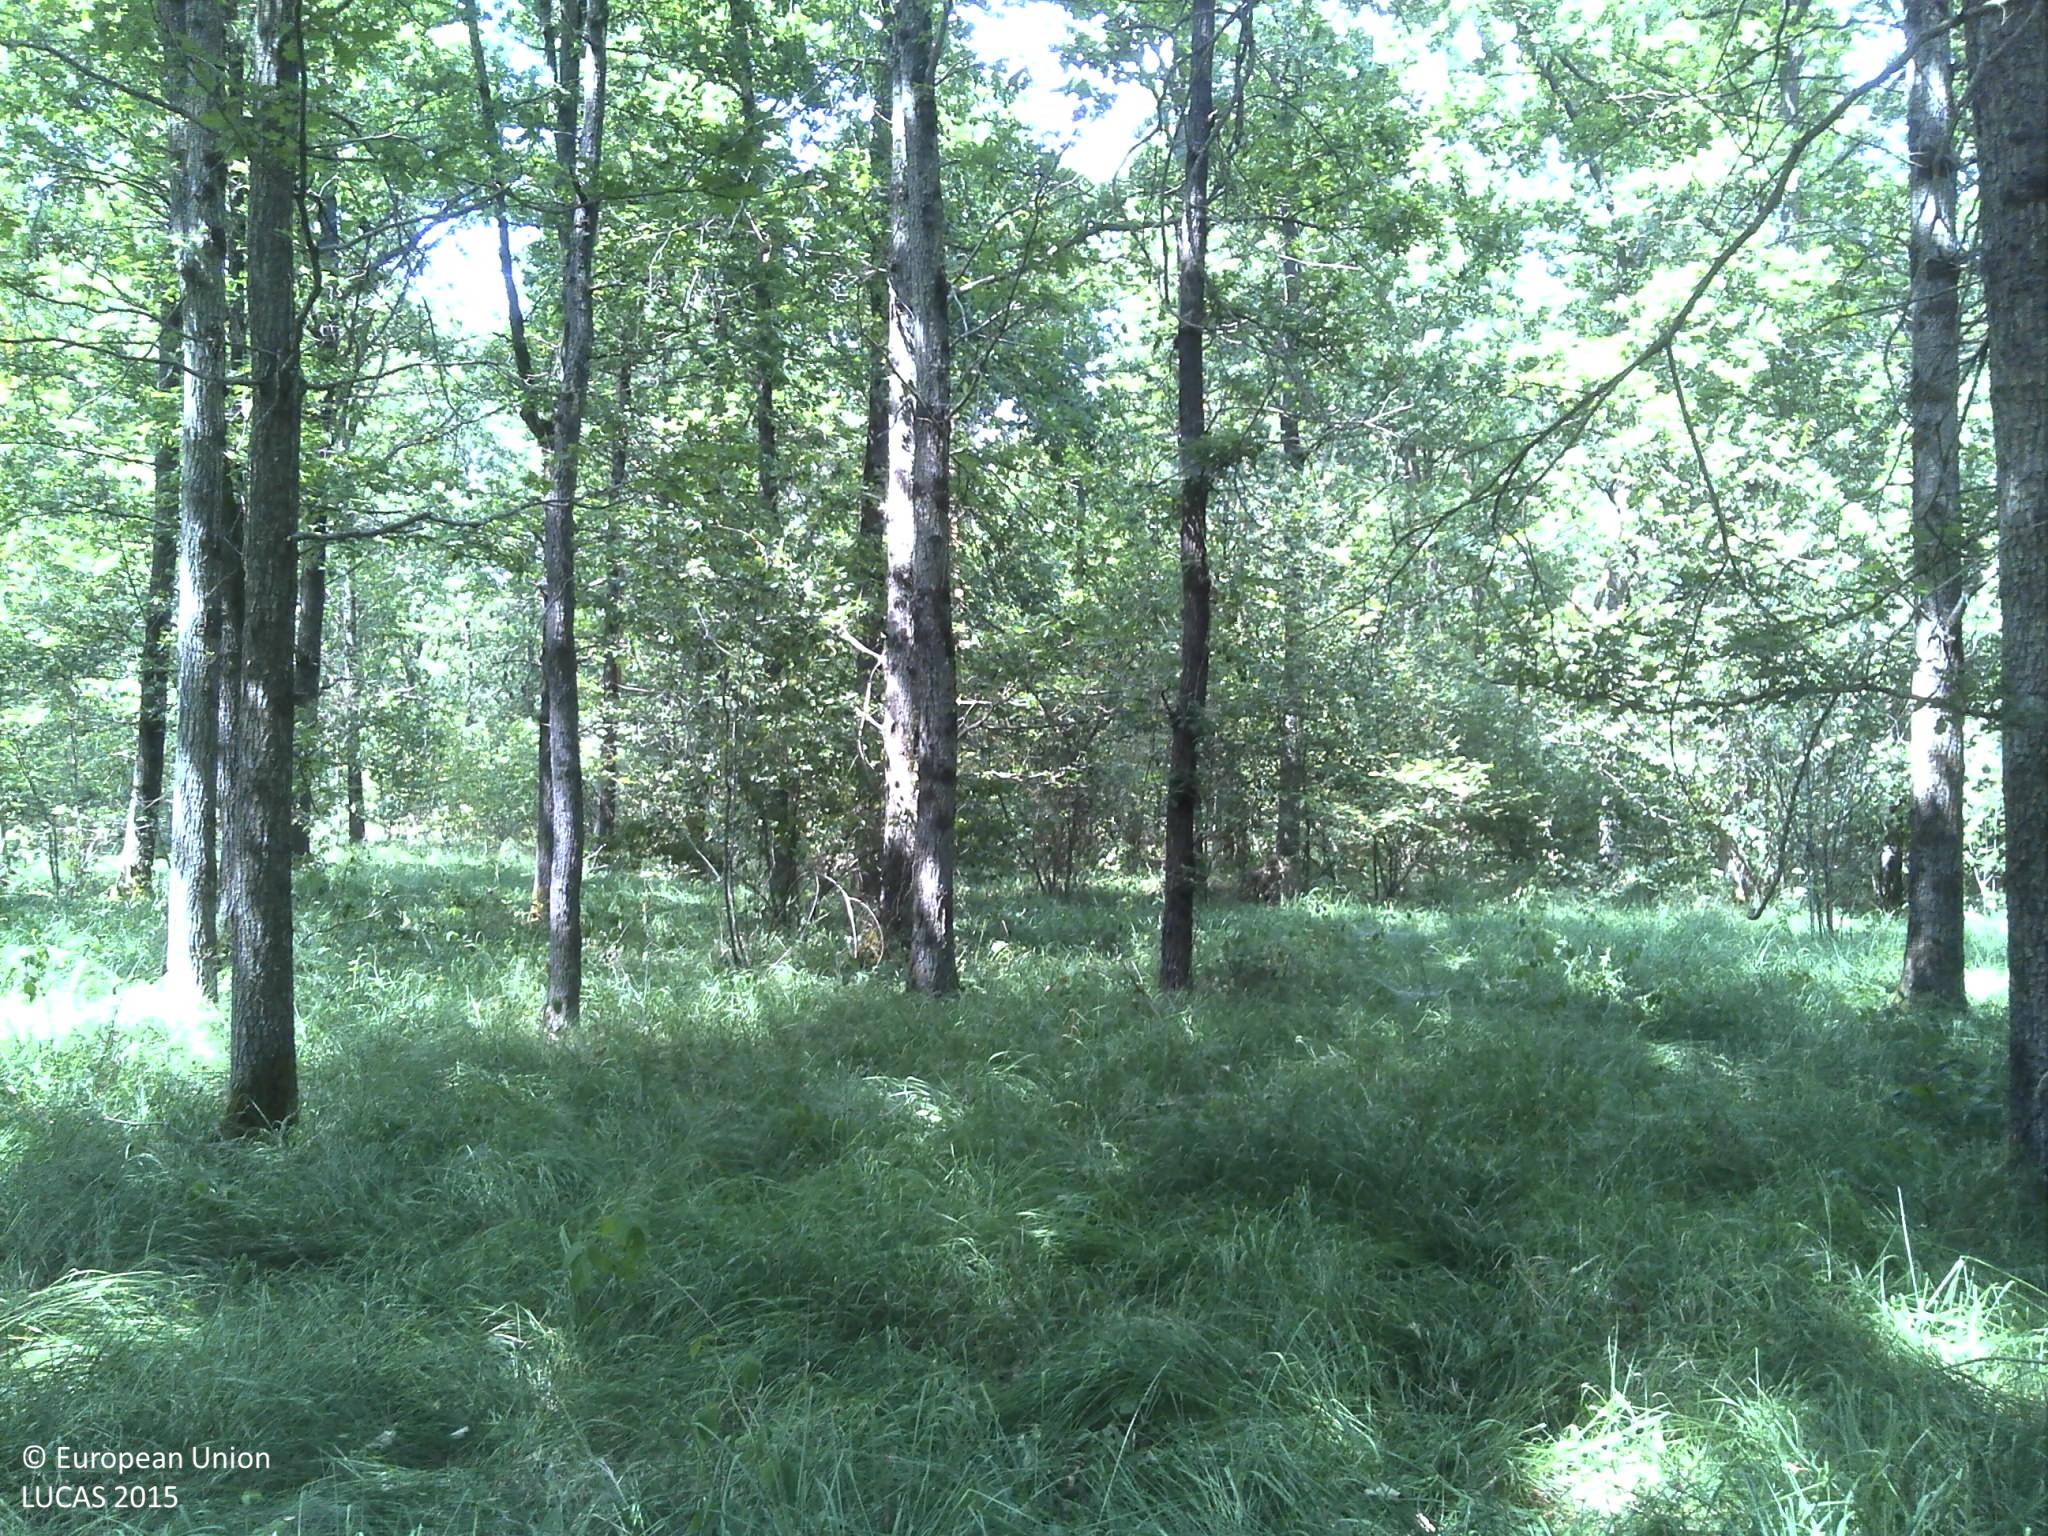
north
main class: Woodland
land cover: Broadleaved woodland
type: acidophilous oak and oak-birch forest
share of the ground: > 75 %
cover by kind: broadleaved forest trees 80 %, herbaceous plants 15 %, shrubs 5 %
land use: Forestry
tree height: > 5 m
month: July
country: FR
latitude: 45.8447
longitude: 4.0919
